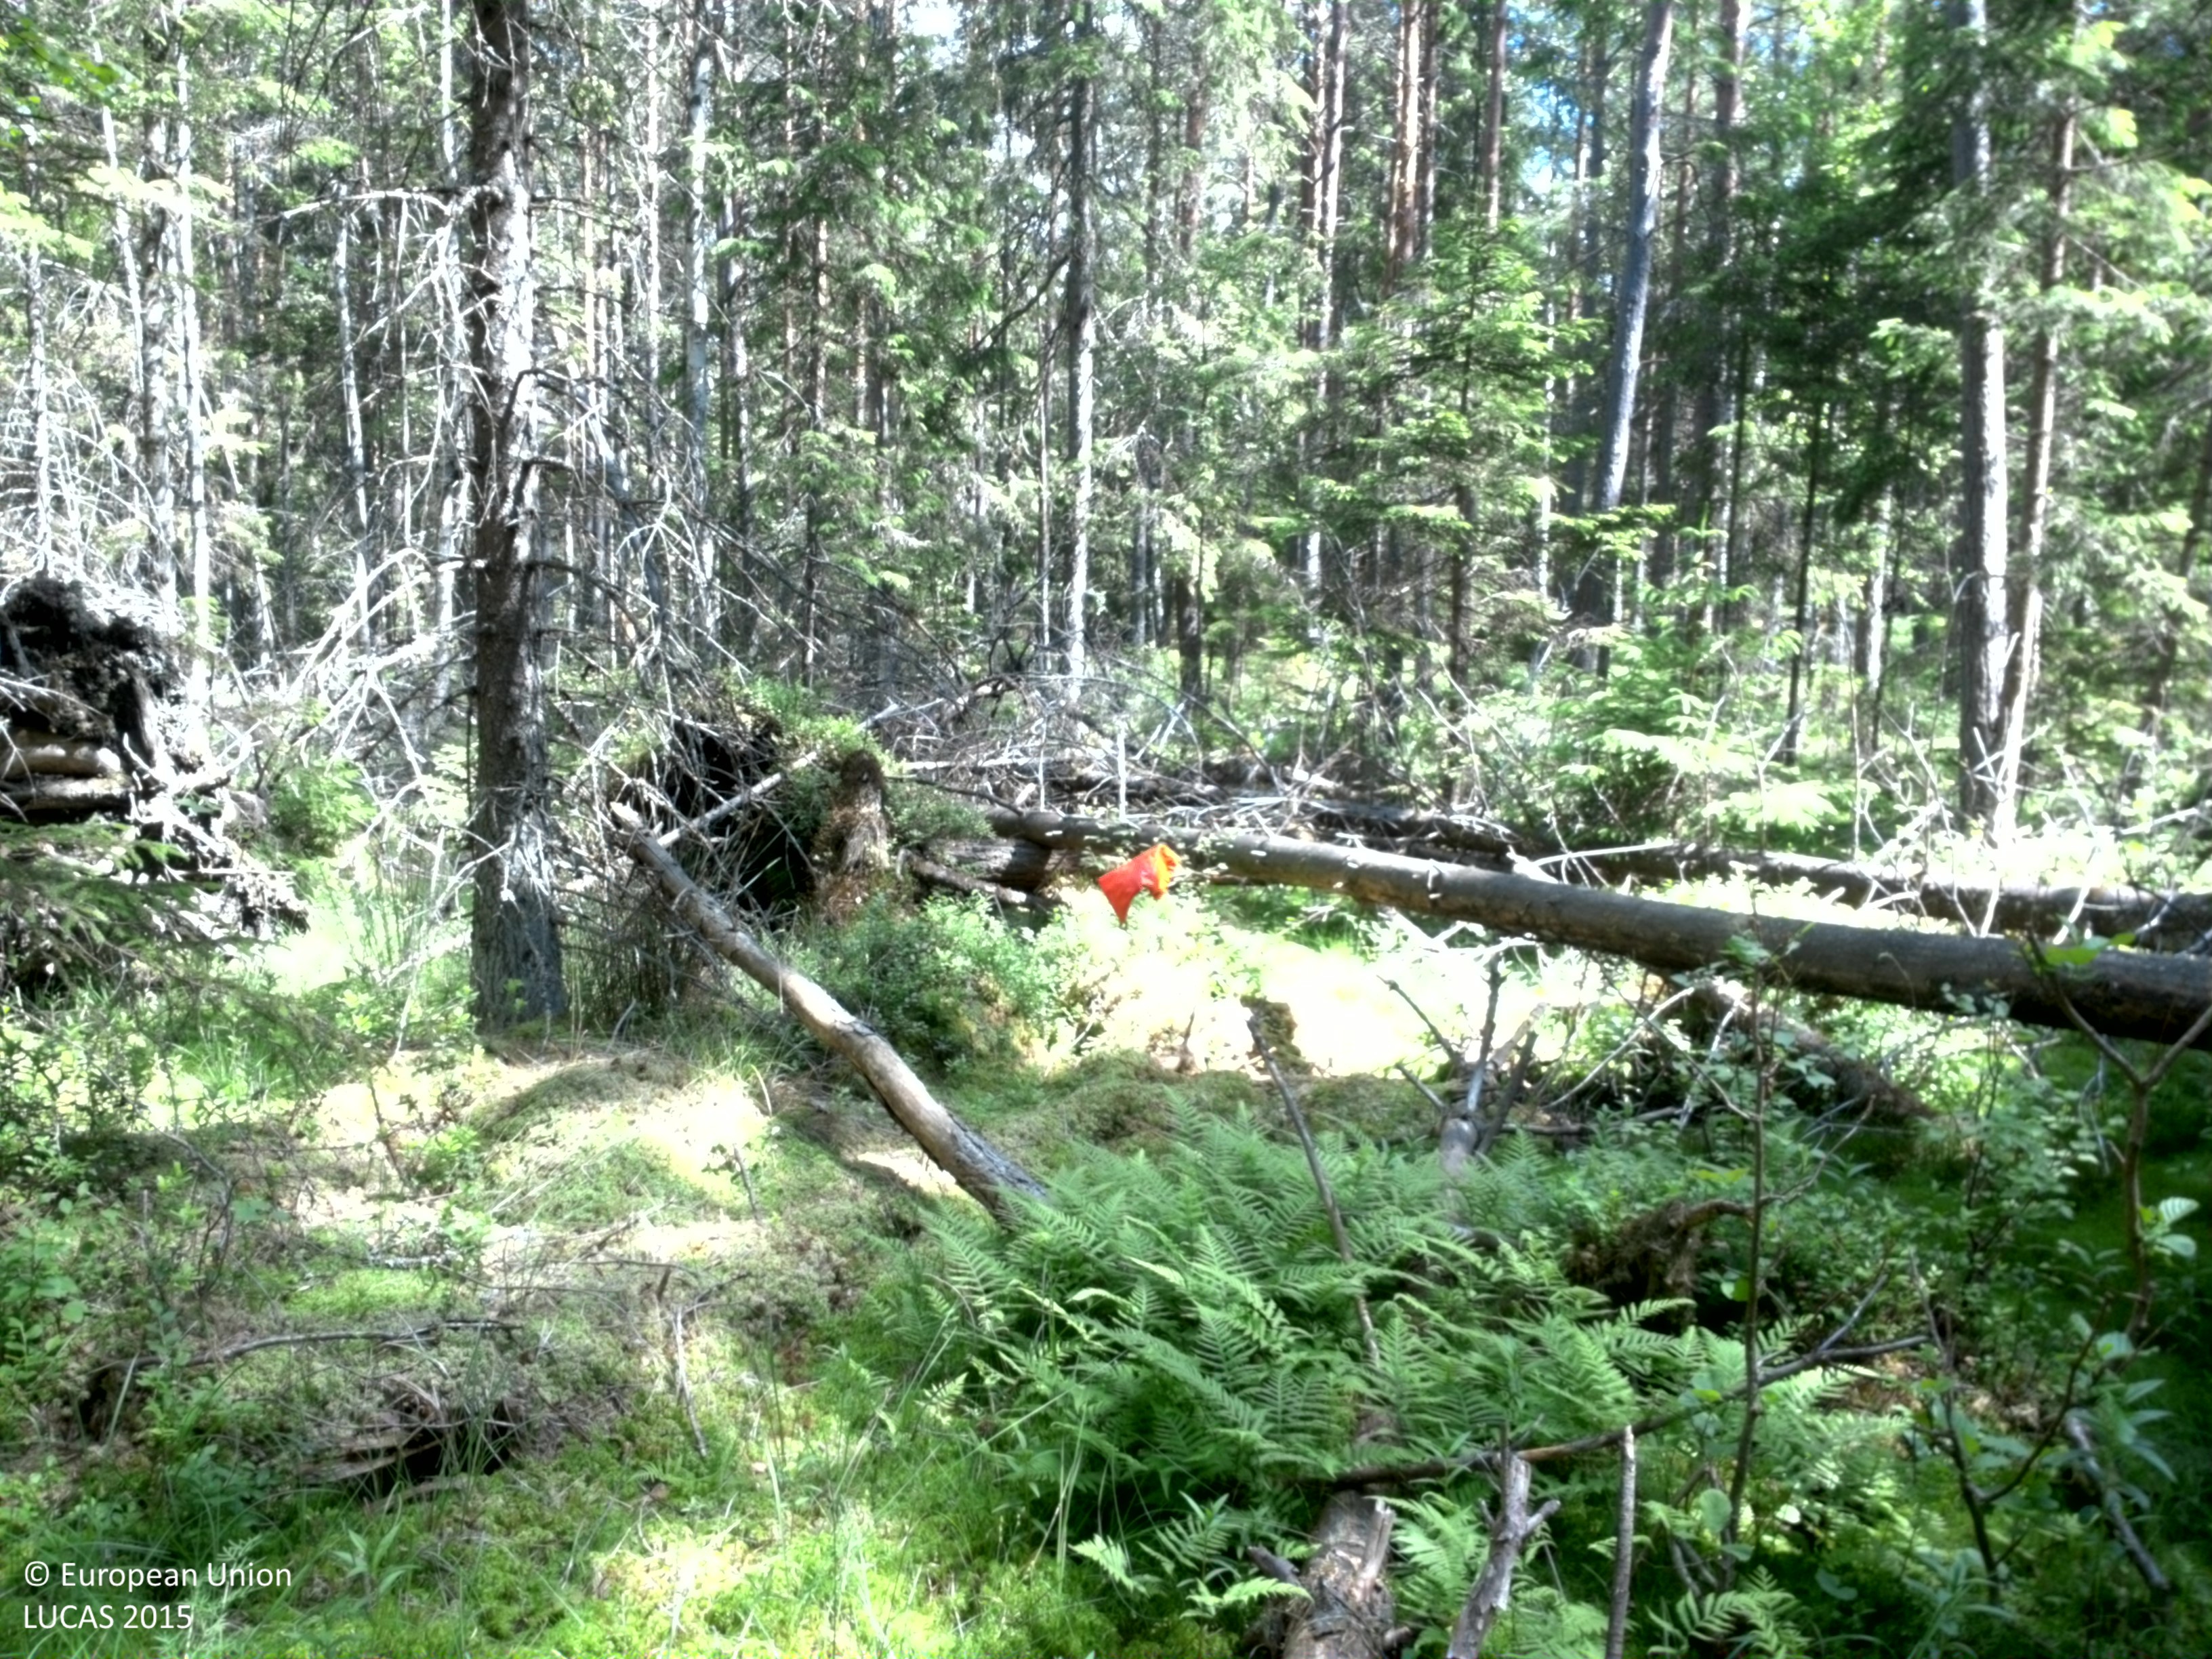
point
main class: Woodland
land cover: Pine dominated mixed woodland
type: boreal forest
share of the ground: 25 - 50 %
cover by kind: herbaceous plants 30 %, lichens and mosses 30 %, coniferous forest trees 25 %, broadleaved forest trees 15 %
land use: Forestry
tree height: > 5 m
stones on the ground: 25 - 50 %
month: June
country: SE
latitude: 58.5822
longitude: 15.3428
